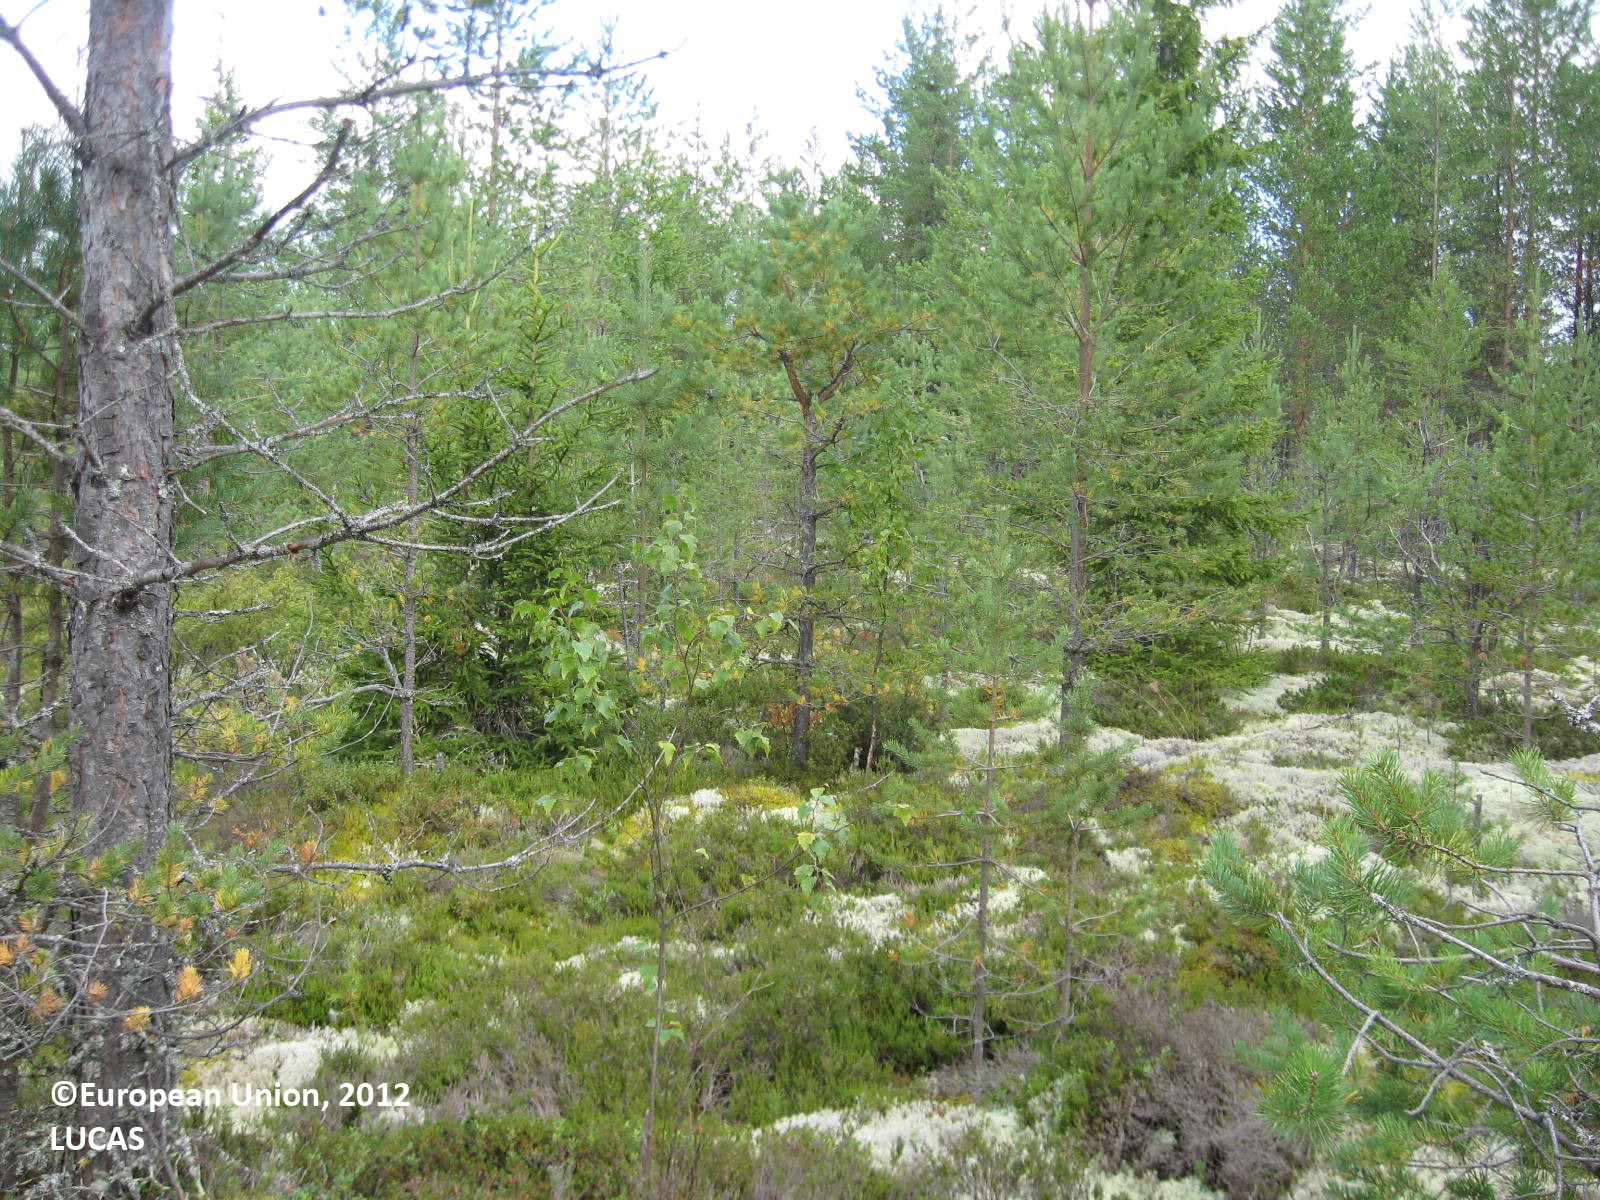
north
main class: Woodland
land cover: Pine dominated coniferous woodland
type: boreal forest
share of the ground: 50 - 75 %
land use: Forestry
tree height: > 5 m
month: August
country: FI
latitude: 63.4782
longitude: 30.2722
